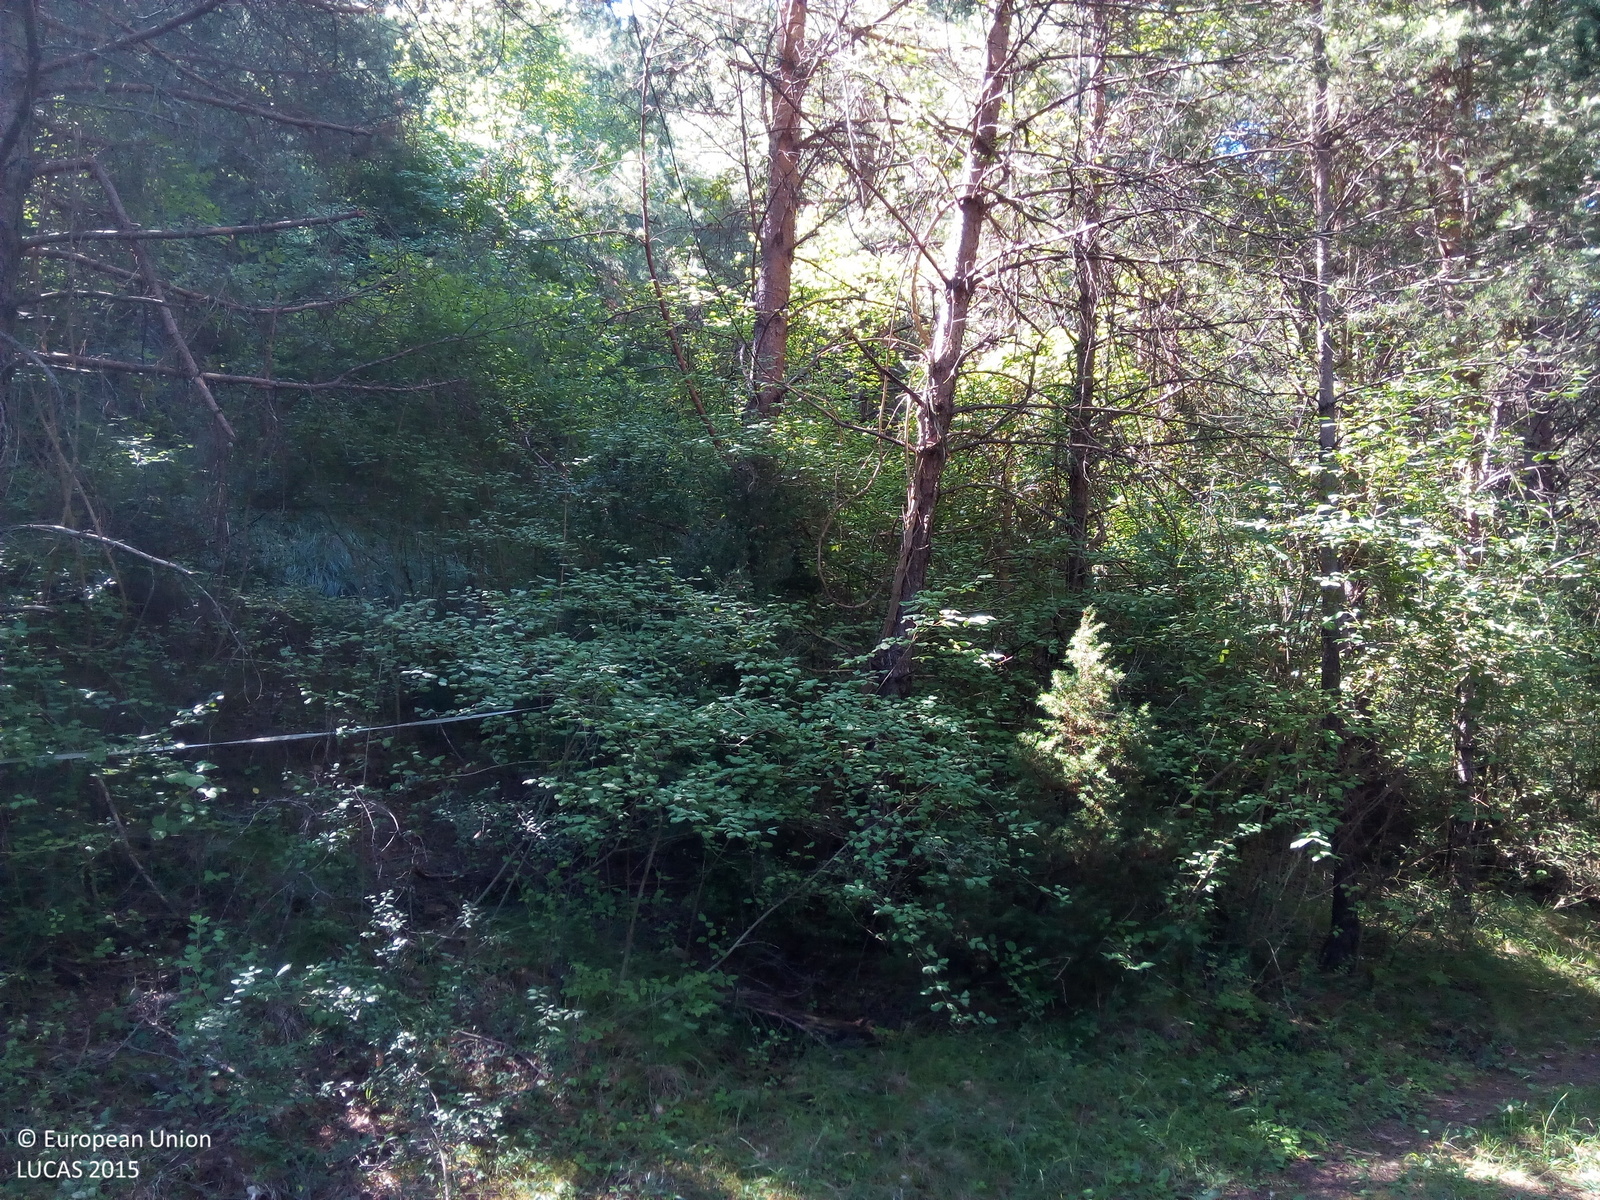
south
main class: Woodland
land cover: Pine dominated mixed woodland
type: coniferous forest of the mediterranean region
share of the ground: > 75 %
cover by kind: coniferous forest trees 75 %, broadleaved forest trees 25 %
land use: Forestry
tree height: > 5 m
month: August
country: ES
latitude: 42.5413
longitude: 0.2005
